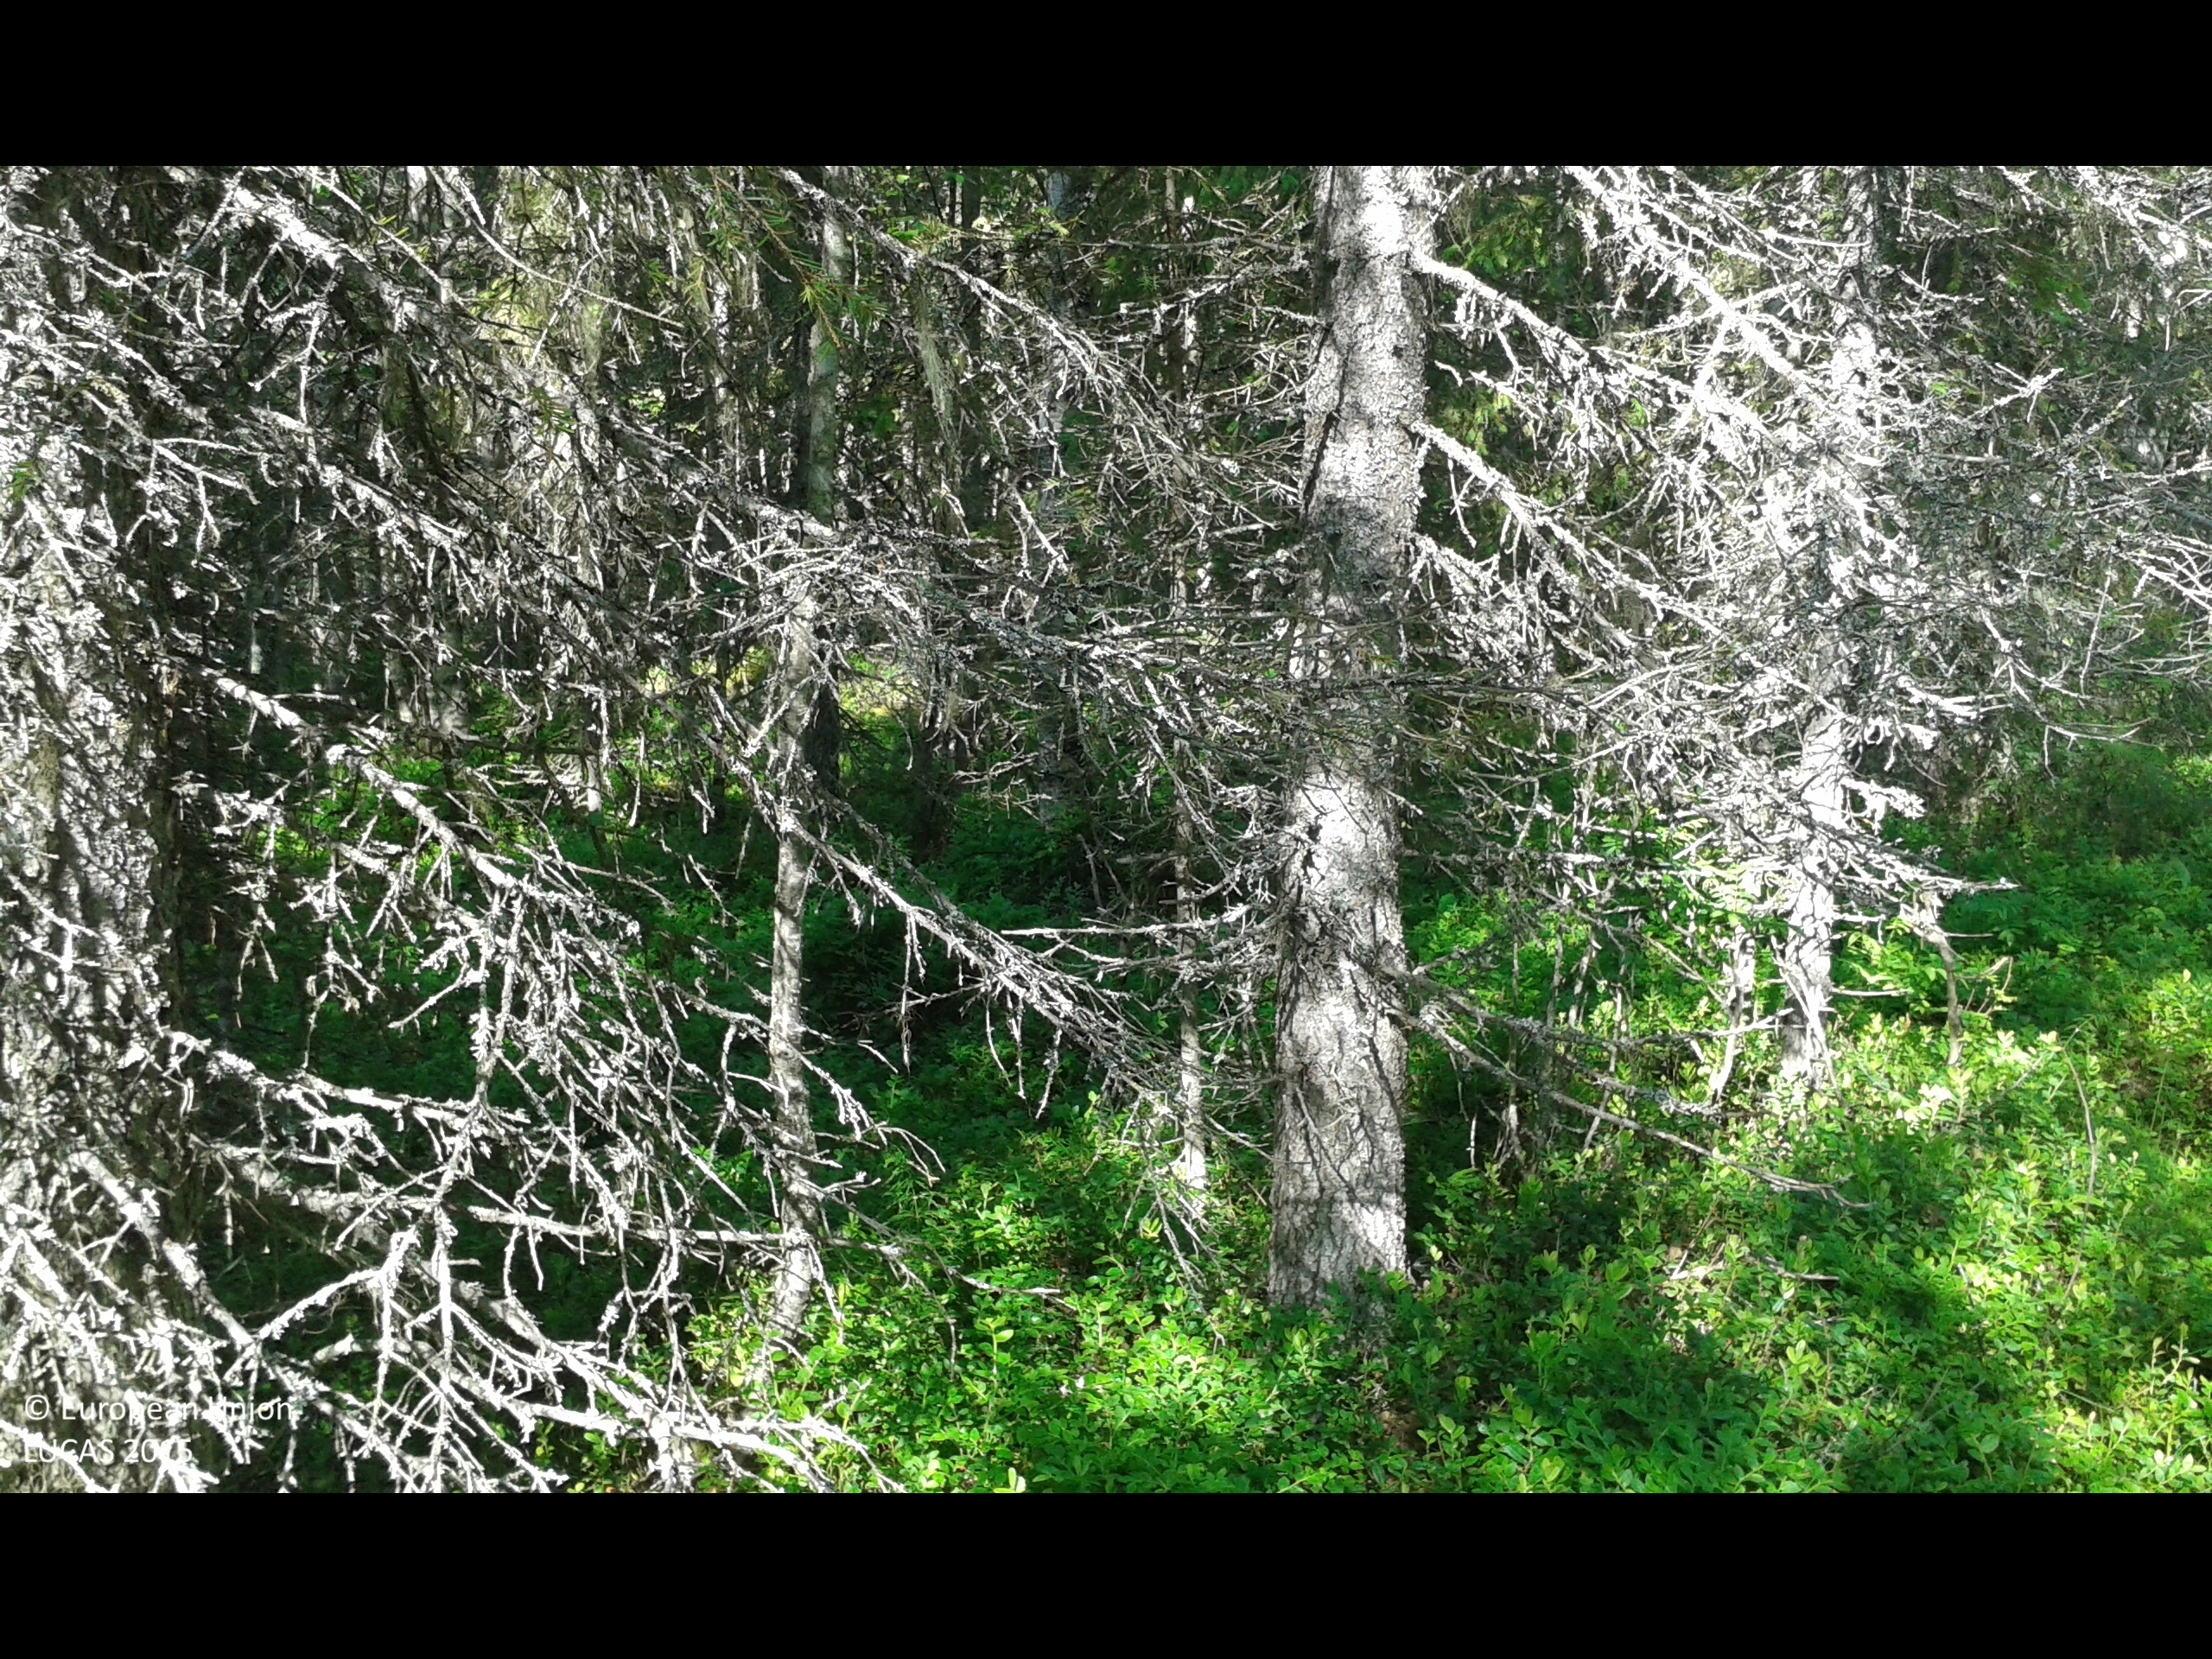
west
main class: Woodland
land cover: Spruce dominated mixed woodland
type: boreal forest
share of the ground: 25 - 50 %
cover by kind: shrubs 55 %, coniferous forest trees 25 %, broadleaved forest trees 20 %
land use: Forestry
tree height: > 5 m
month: July
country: SE
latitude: 66.6186
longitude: 23.6919
